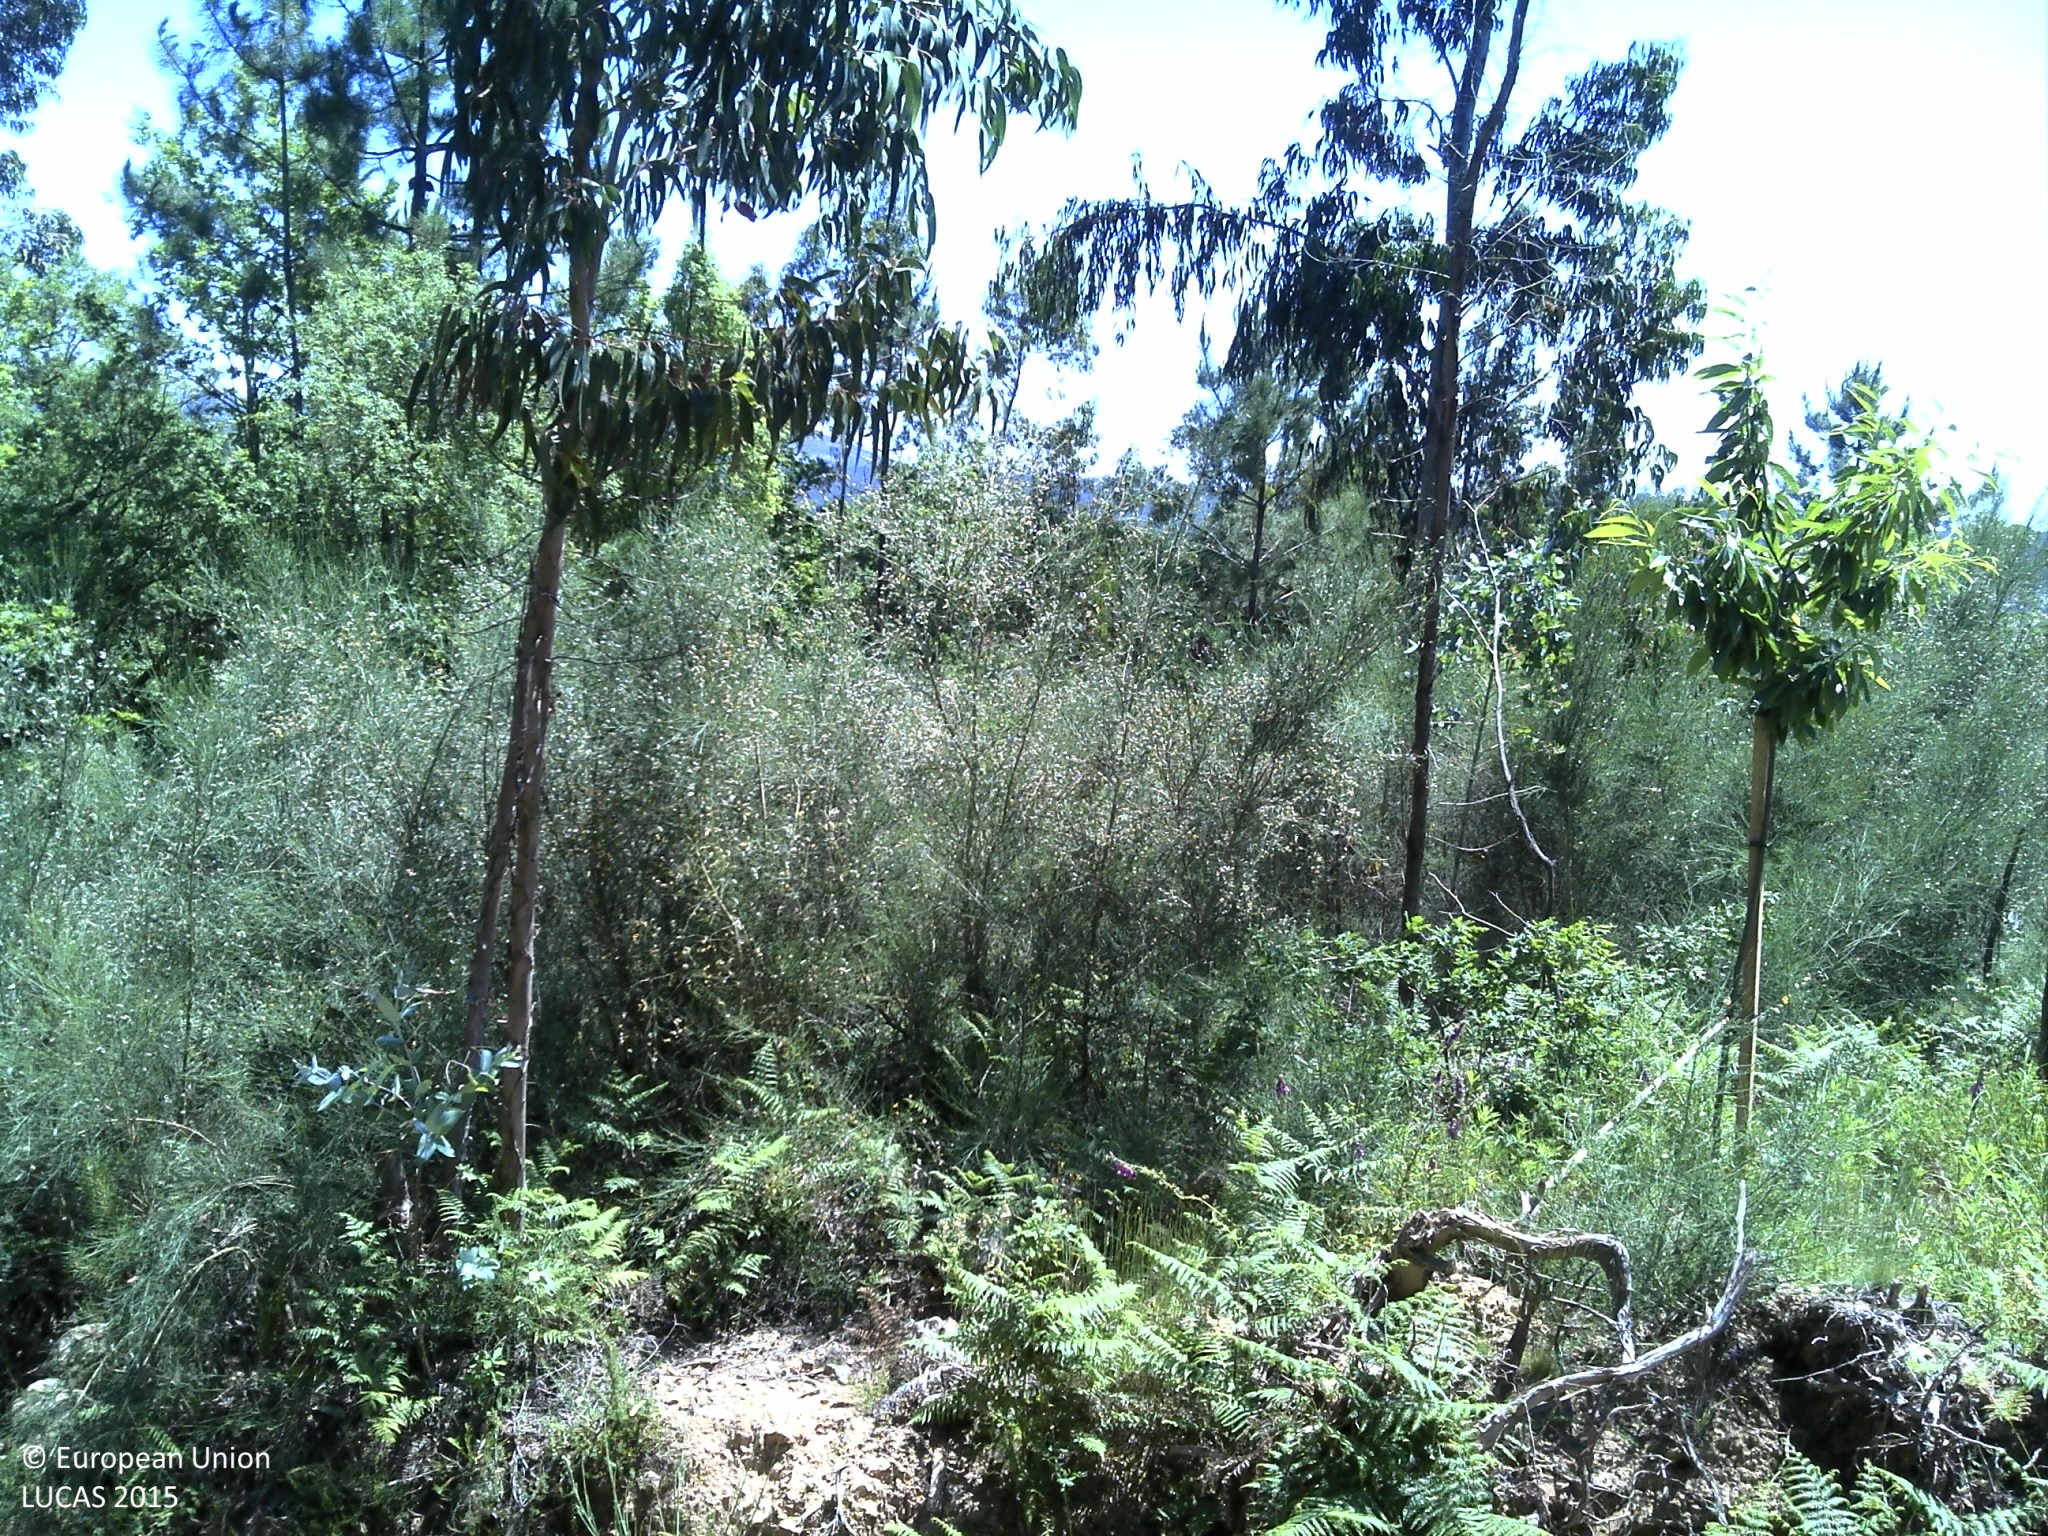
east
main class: Woodland
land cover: Broadleaved woodland
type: exotic forest
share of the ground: 25 - 50 %
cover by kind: broadleaved forest trees 50 %, shrubs 35 %, unconsolidated bare surface 10 %, herbaceous plants 5 %
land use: Forestry
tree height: > 5 m
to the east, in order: Broadleaved woodland; Tracks; Broadleaved woodland; Grassland without tree/shrub cover; Vineyards; Electric lines; Vineyards; Grassland without tree/shrub cover; Vineyards; Electric lines; Dry stone walls; Paved roads, cycling and walking lanes; Grassland without tree/shrub cover; Other fresh vegetables; Grassland without tree/shrub cover; Vineyards; Maize; Rivers and streams; Pine dominated mixed woodland; Arable land (only in case pi)
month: May
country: PT
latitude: 41.6843
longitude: -8.6270
